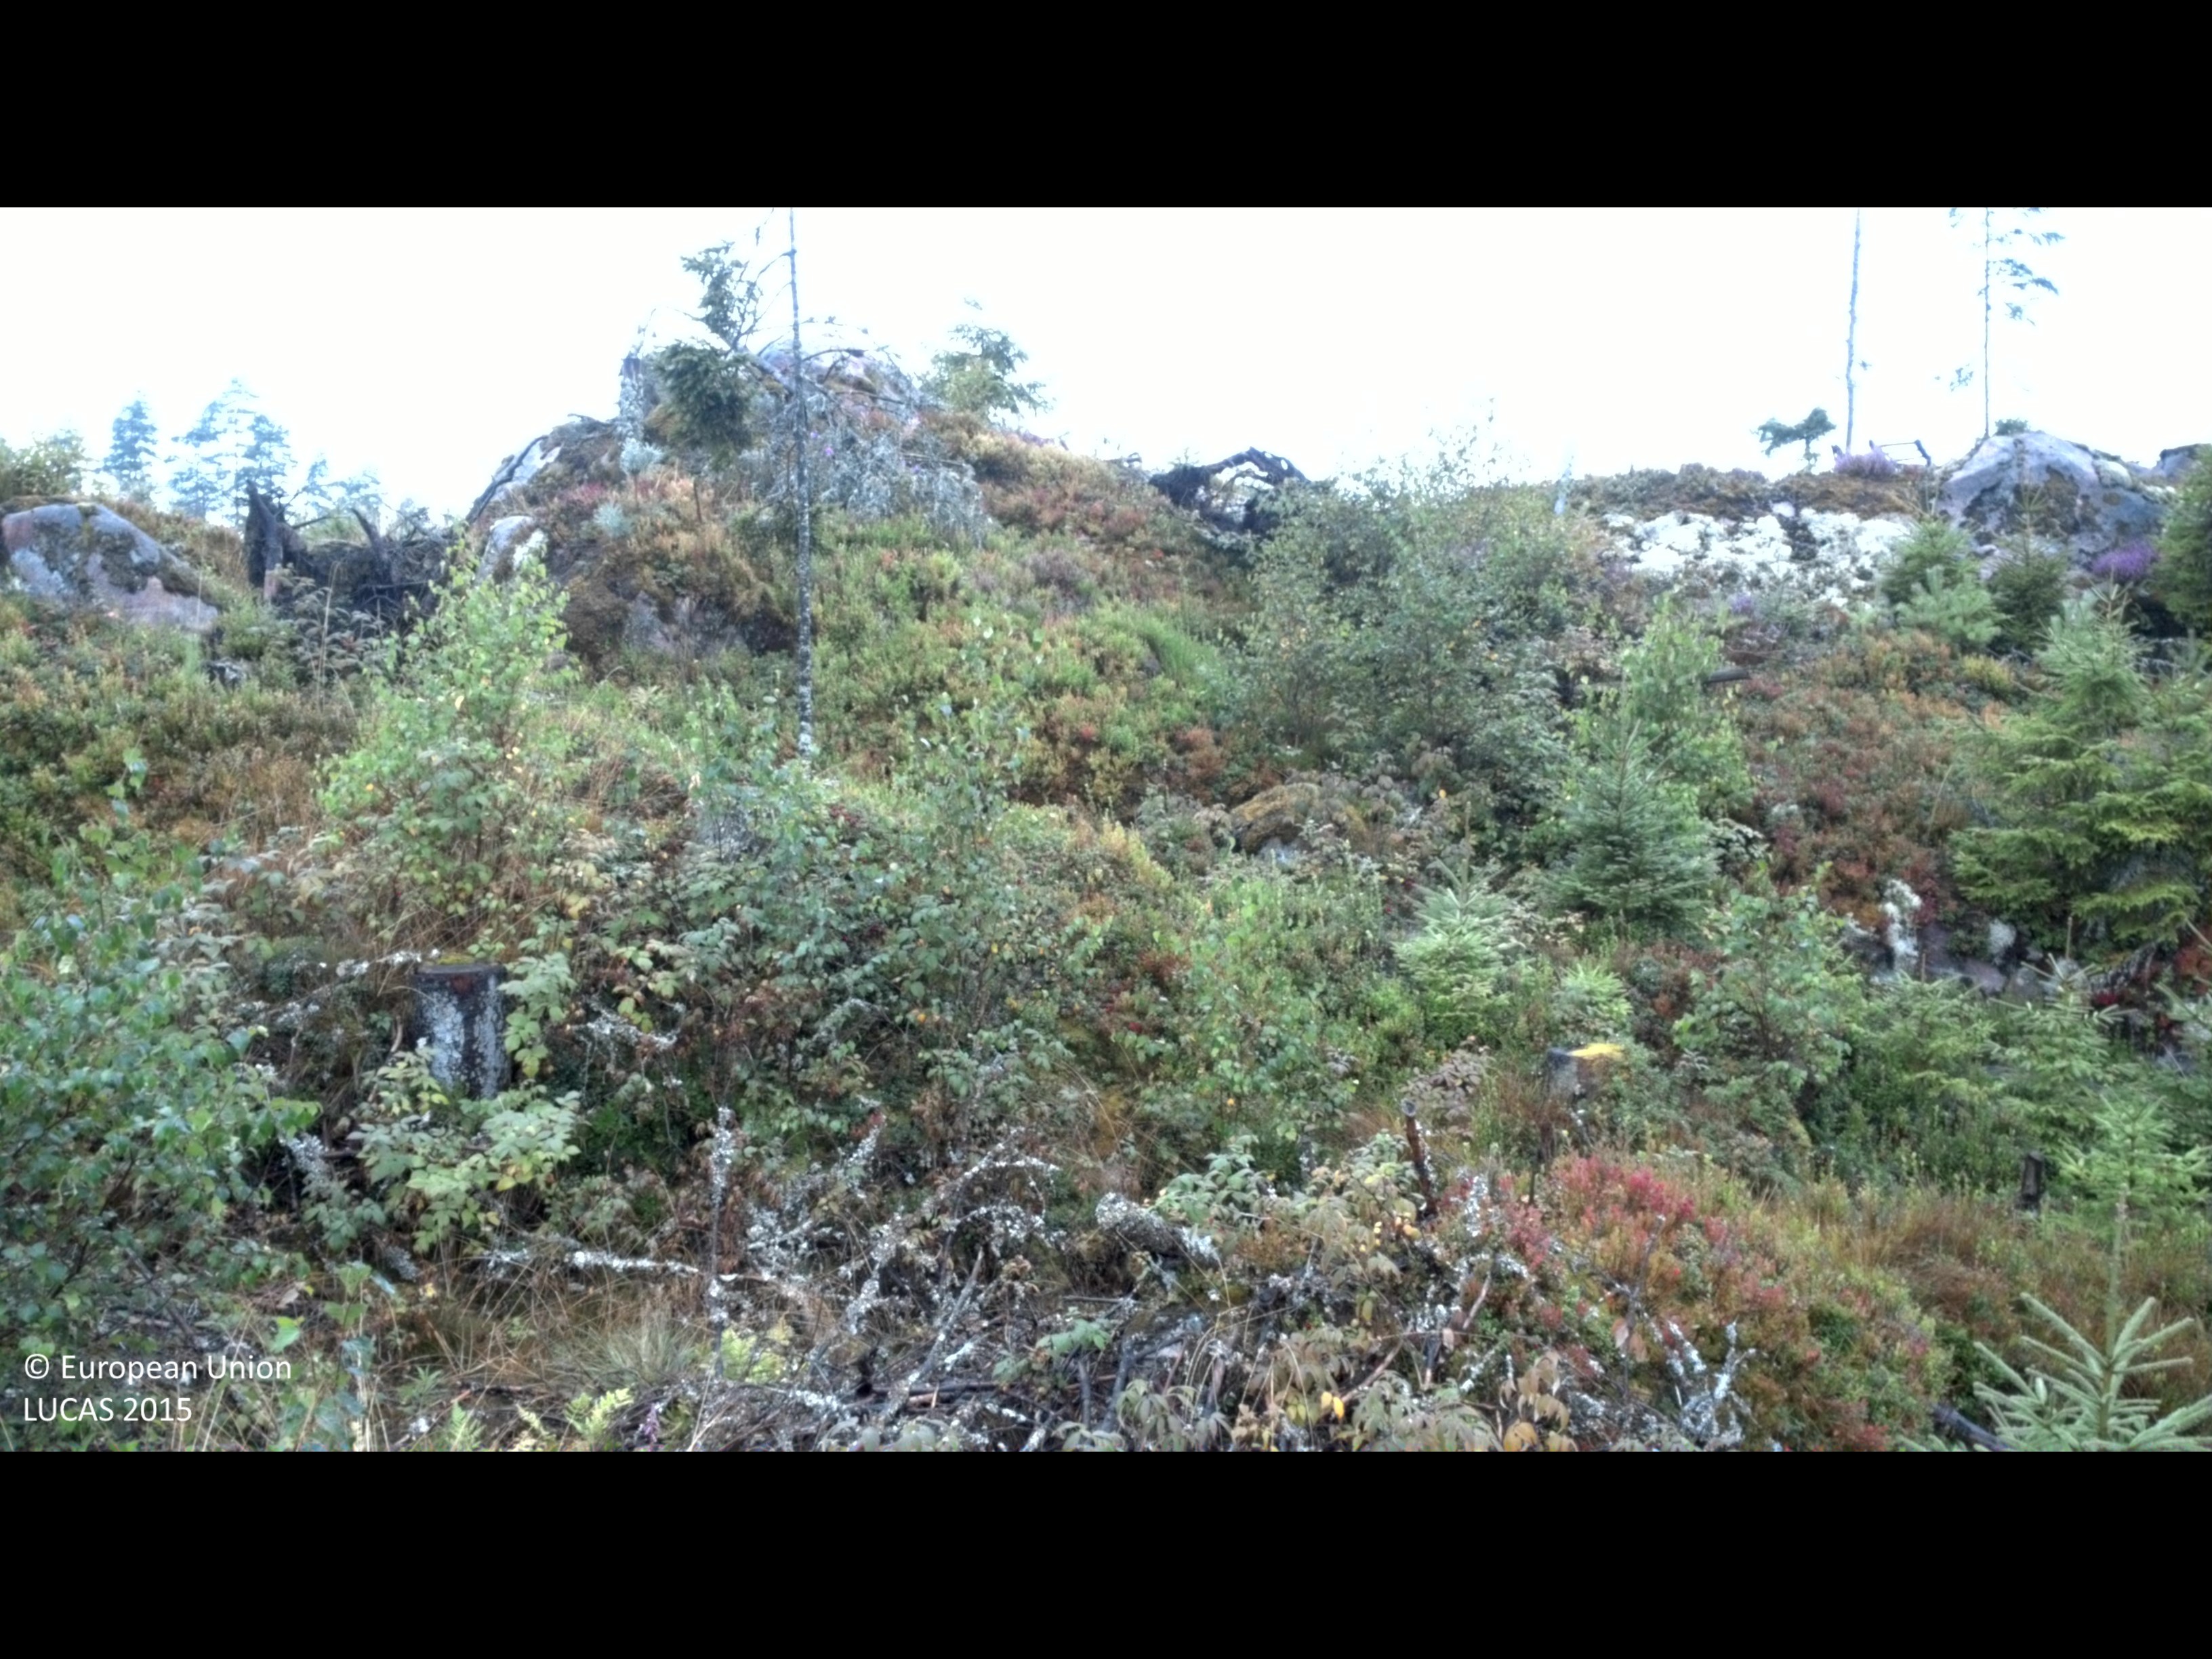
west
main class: Woodland
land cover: Spruce dominated mixed woodland
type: boreal forest
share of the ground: 10 - 25 %
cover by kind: shrubs 60 %, coniferous forest trees 15 %, broadleaved forest trees 10 %, herbaceous plants 10 %, lichens and mosses 5 %
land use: Forestry
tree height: < 5 m
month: September
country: SE
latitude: 57.3885
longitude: 13.9053
